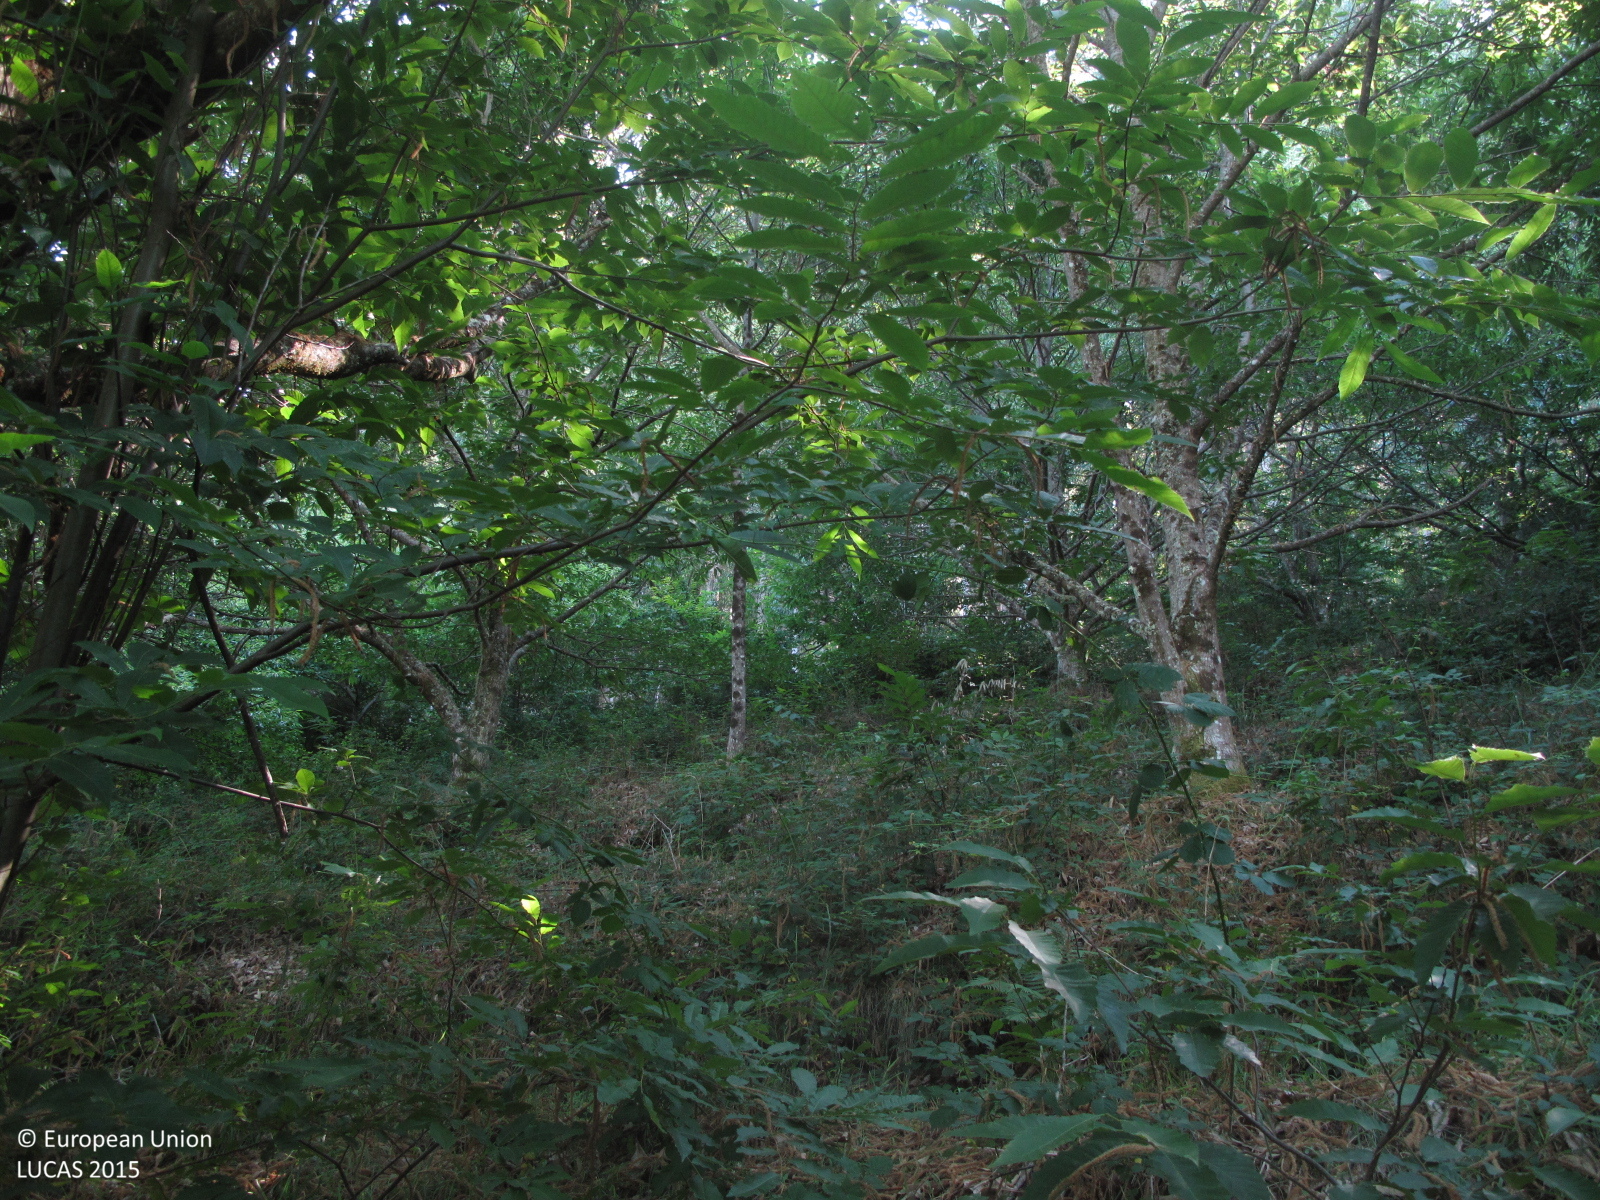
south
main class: Woodland
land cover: Broadleaved woodland
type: thermophilous deciduous forest
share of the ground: > 75 %
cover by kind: broadleaved forest trees 100 %
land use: Forestry
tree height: > 5 m
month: July
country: ES
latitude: 43.3213
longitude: -8.1640
